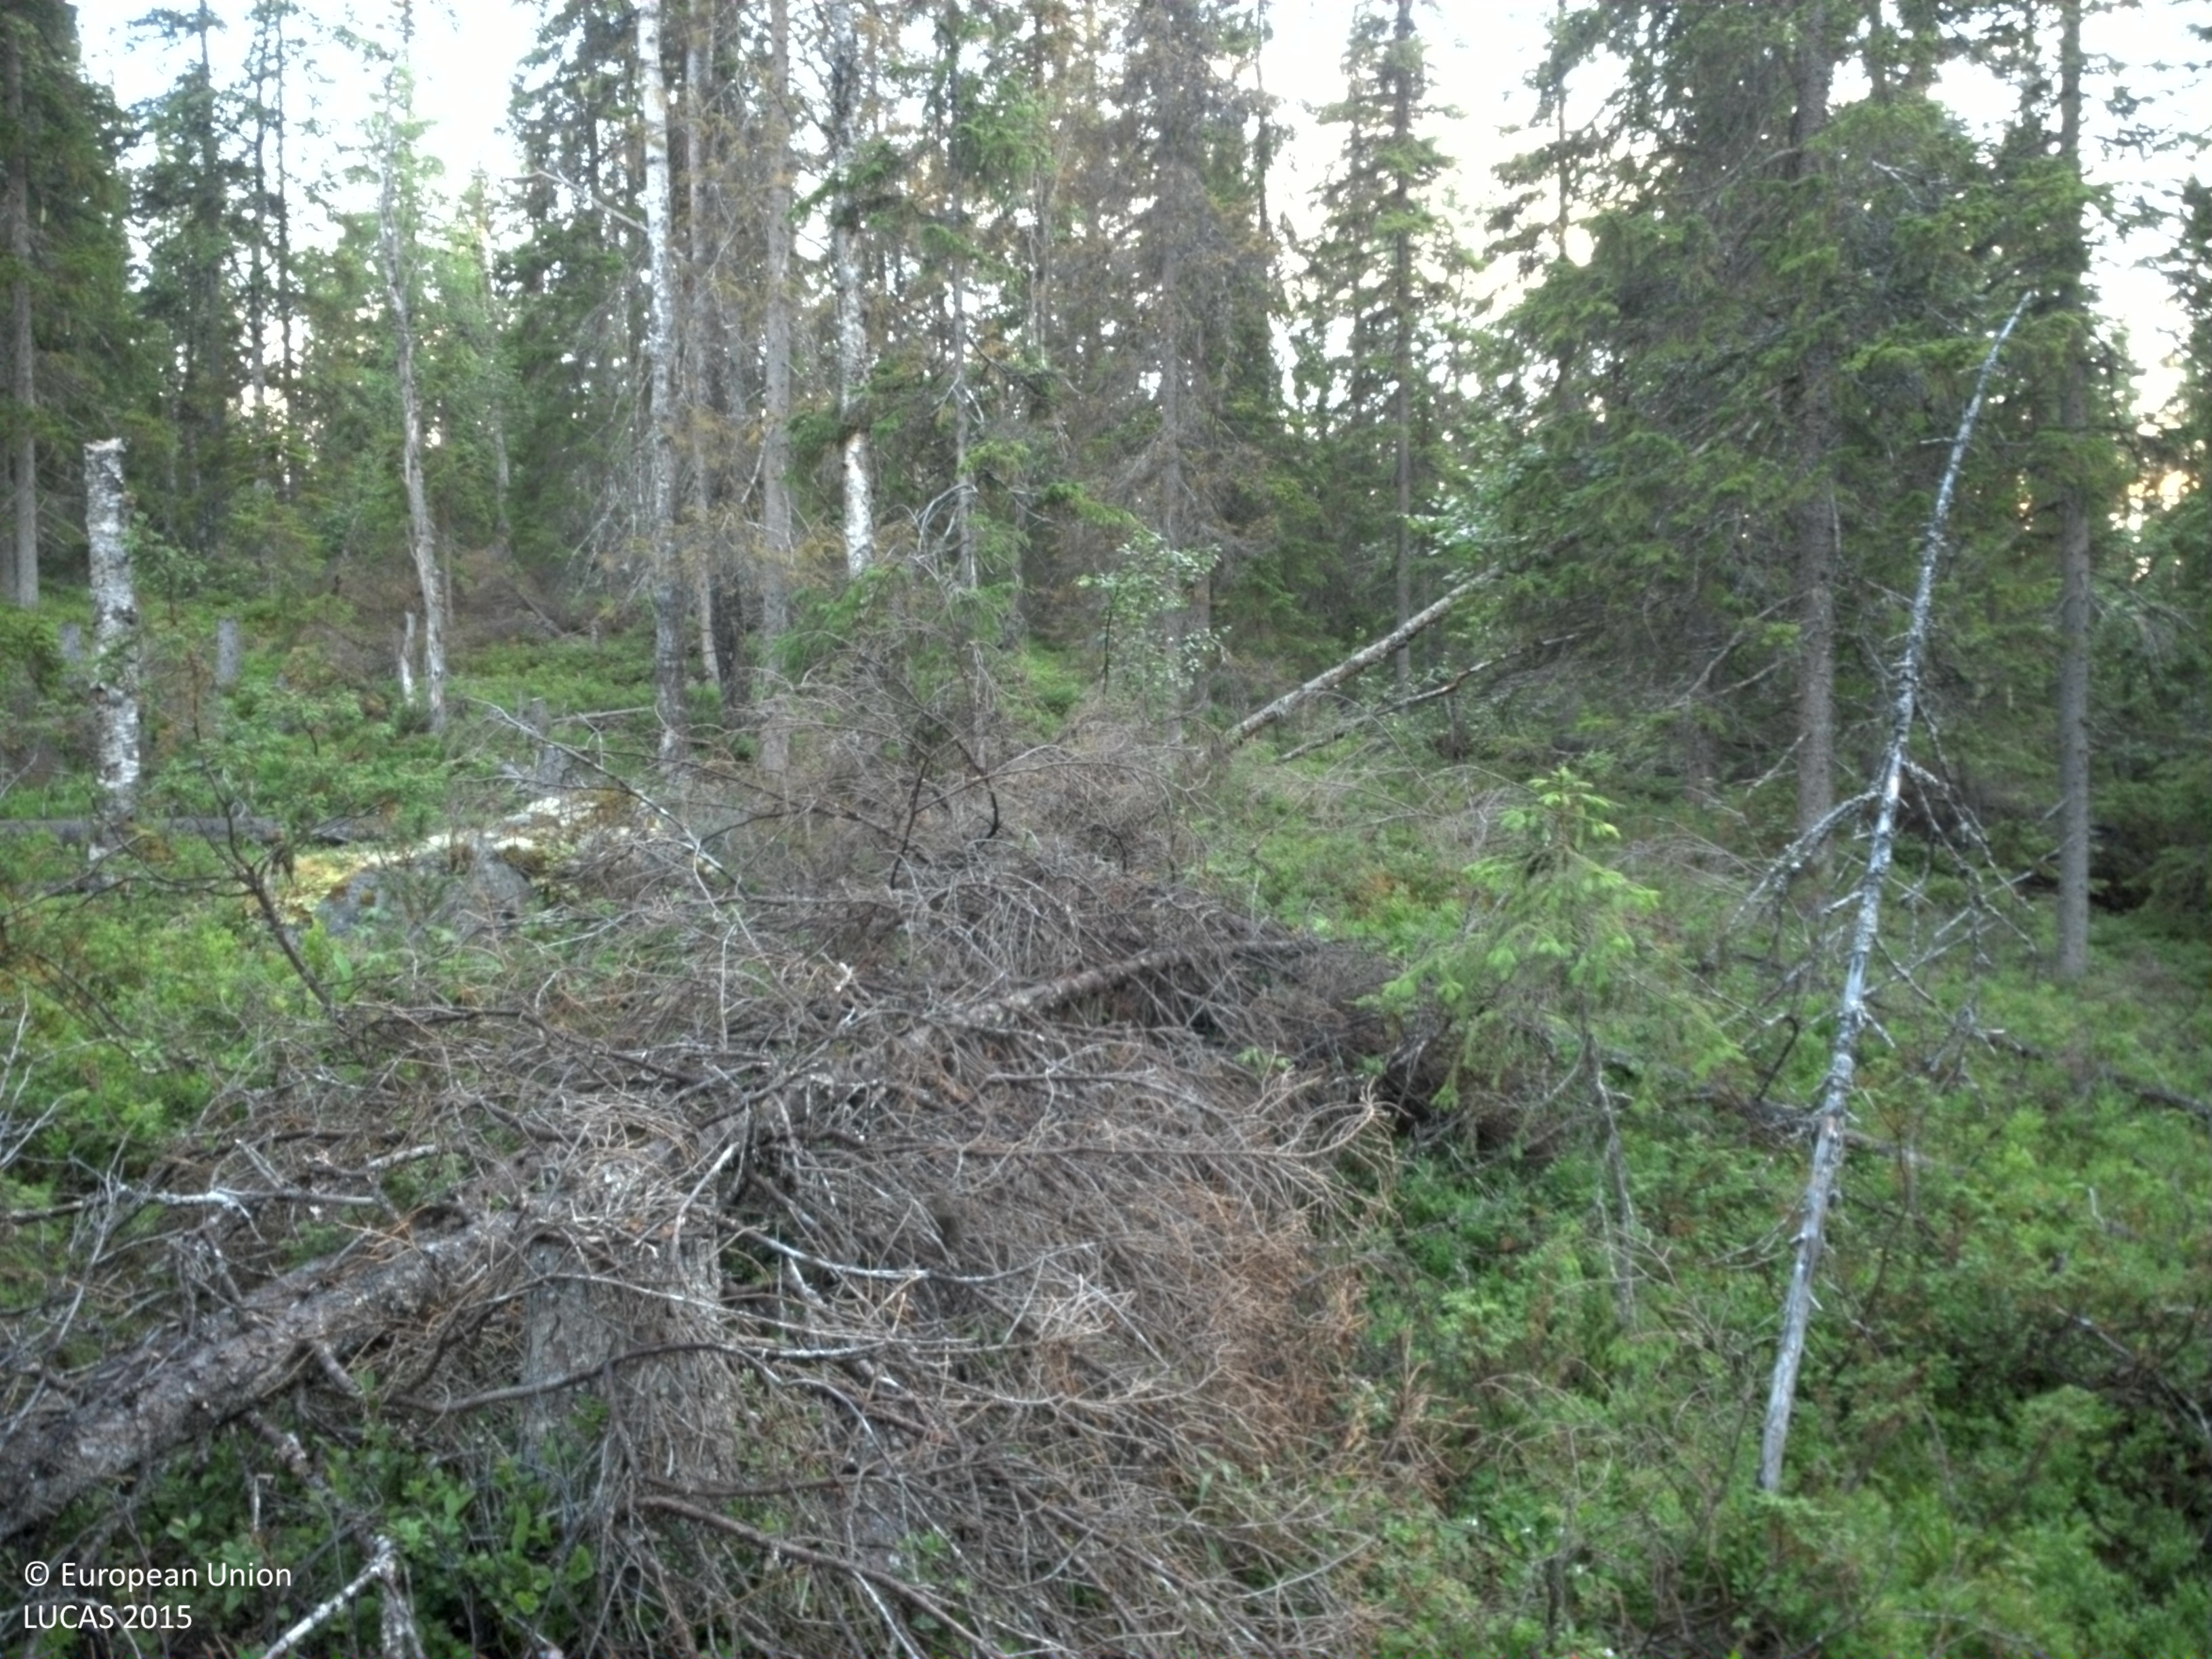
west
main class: Woodland
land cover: Spruce dominated coniferous woodland
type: boreal forest
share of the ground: 10 - 25 %
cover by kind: shrubs 50 %, coniferous forest trees 20 %, lichens and mosses 15 %, herbaceous plants 5 %
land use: Forestry
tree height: > 5 m
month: August
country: SE
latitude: 64.8589
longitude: 16.1473
